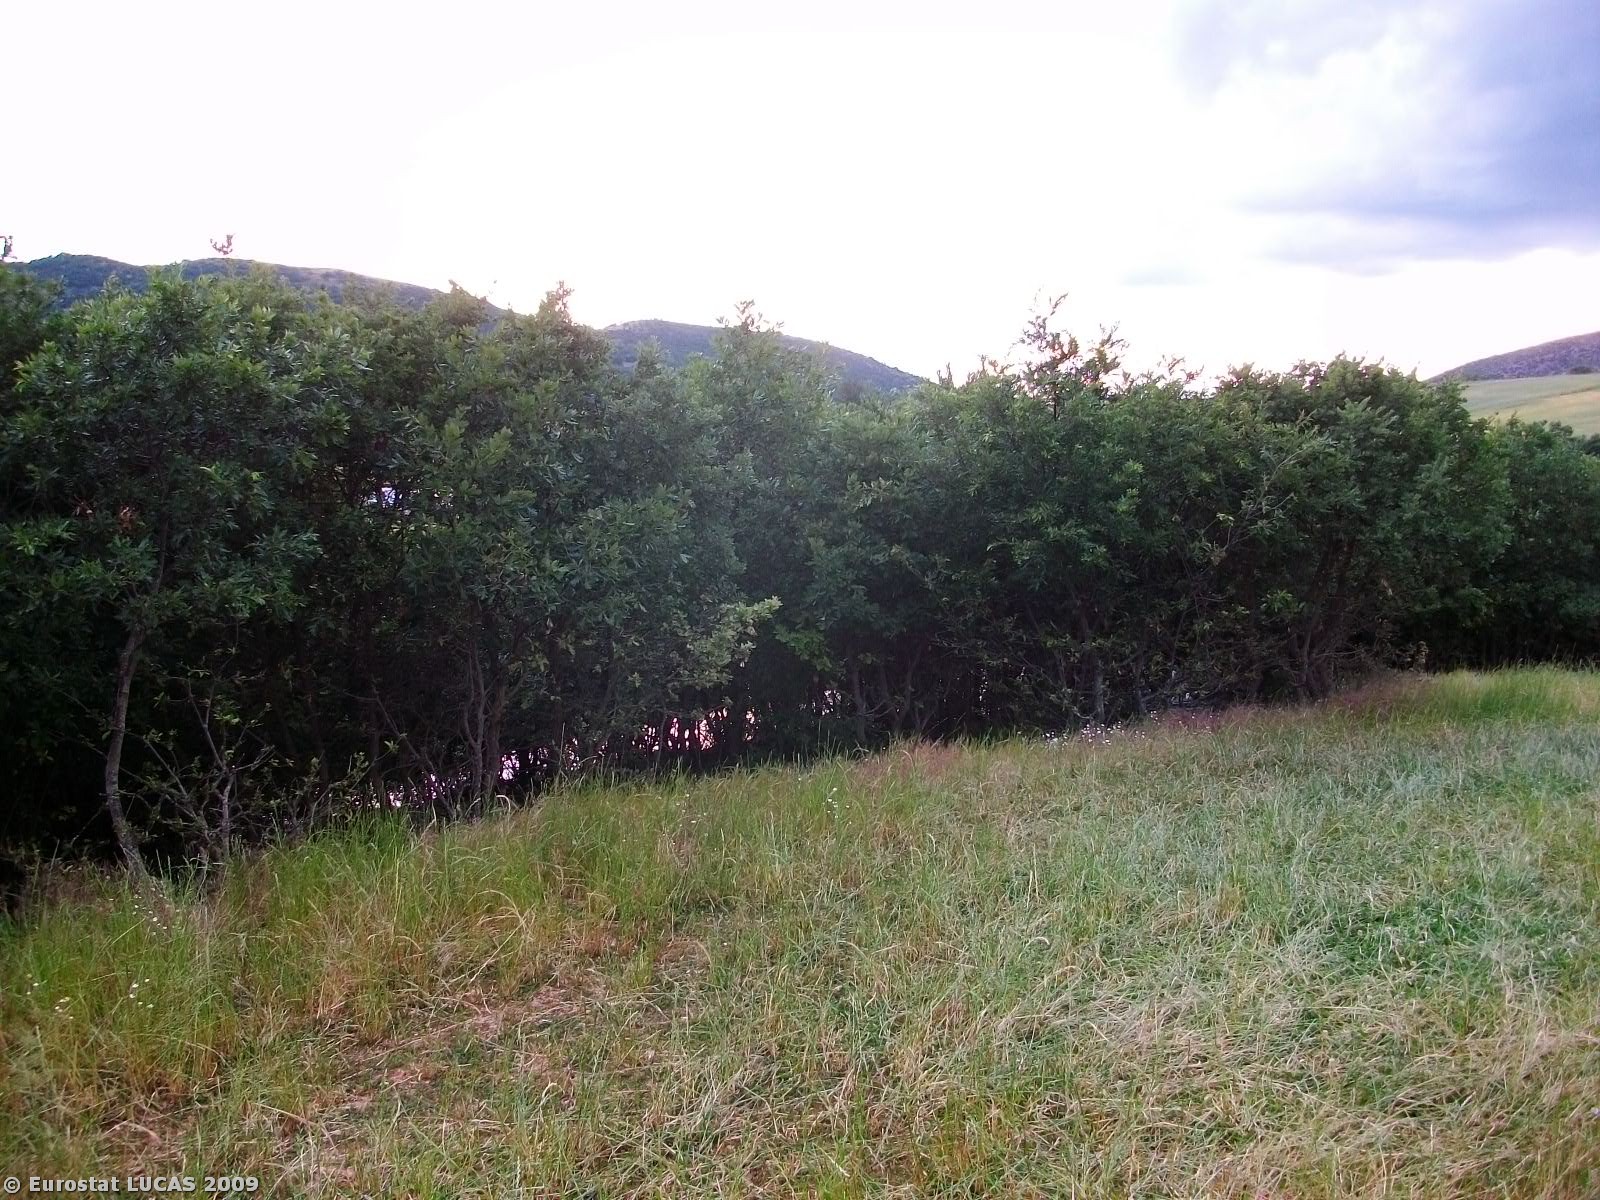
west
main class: Grassland
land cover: Spontaneously vegetated surfaces
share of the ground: > 75 %
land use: Fallow land
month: June
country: GR
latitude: 39.9038
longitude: 21.7660
